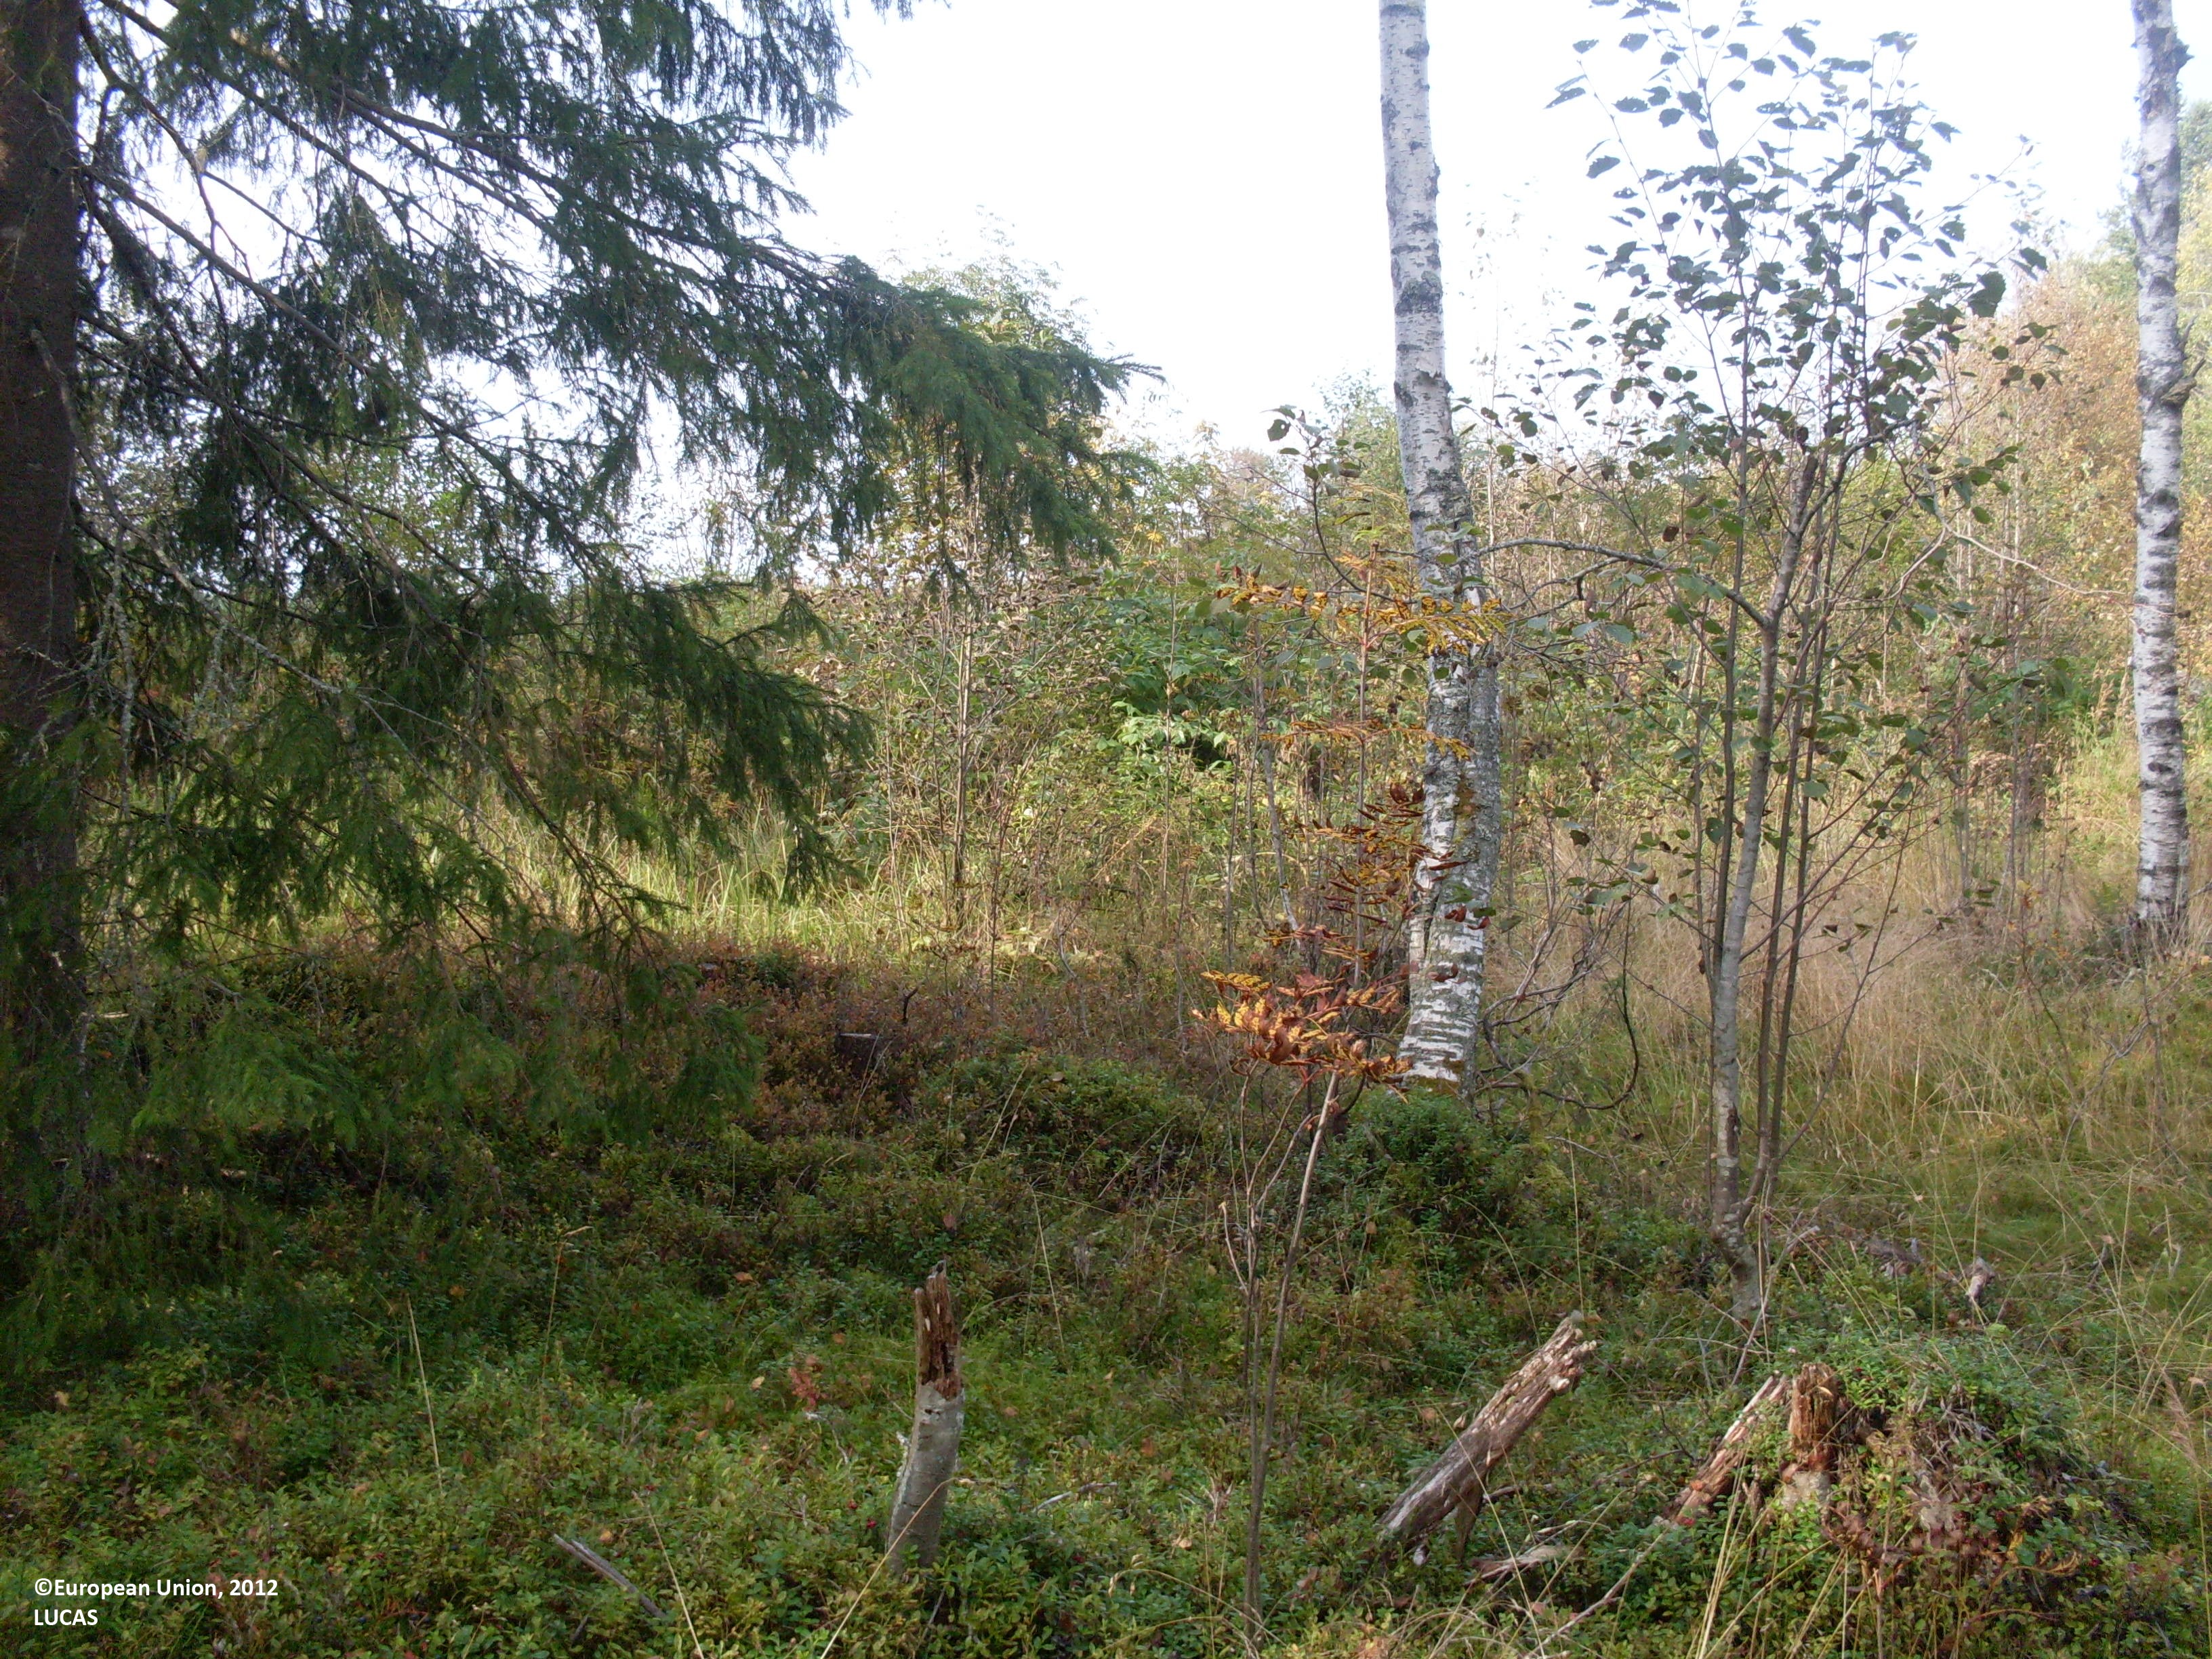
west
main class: Woodland
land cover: Other mixed woodland
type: boreal forest
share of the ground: 50 - 75 %
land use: Forestry
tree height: > 5 m
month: September
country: FI
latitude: 64.2341
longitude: 29.3665
